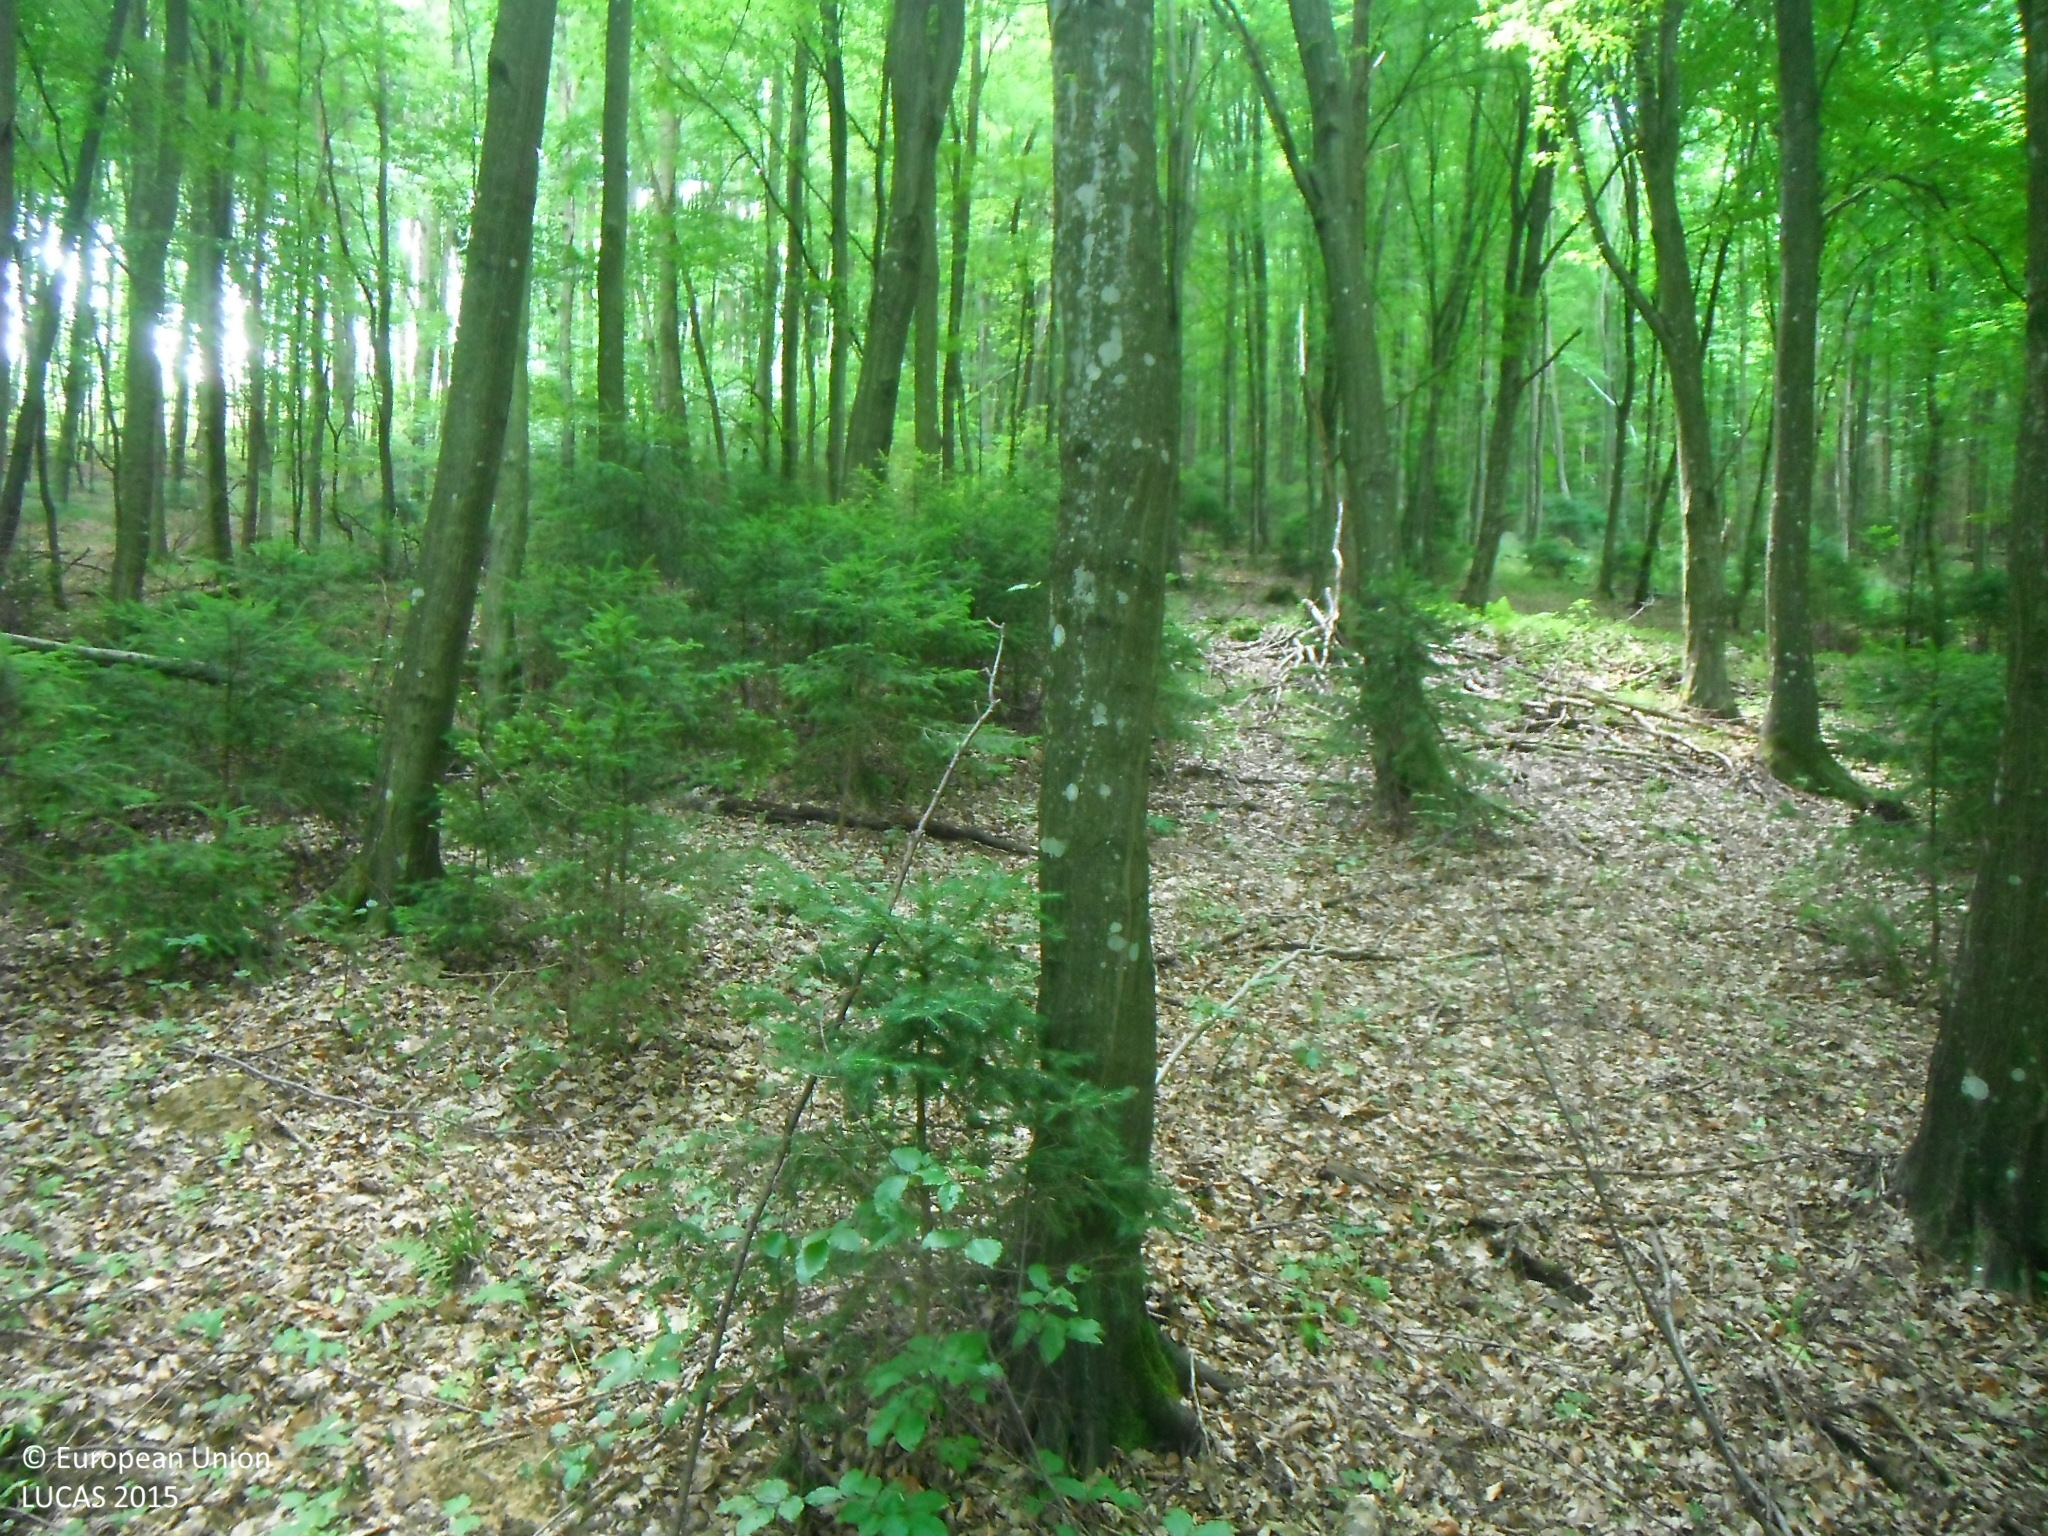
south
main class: Woodland
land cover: Broadleaved woodland
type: beech forest
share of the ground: > 75 %
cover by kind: broadleaved forest trees 100 %
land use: Forestry
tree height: > 5 m
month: June
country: SK
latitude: 48.9087
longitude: 22.3538
